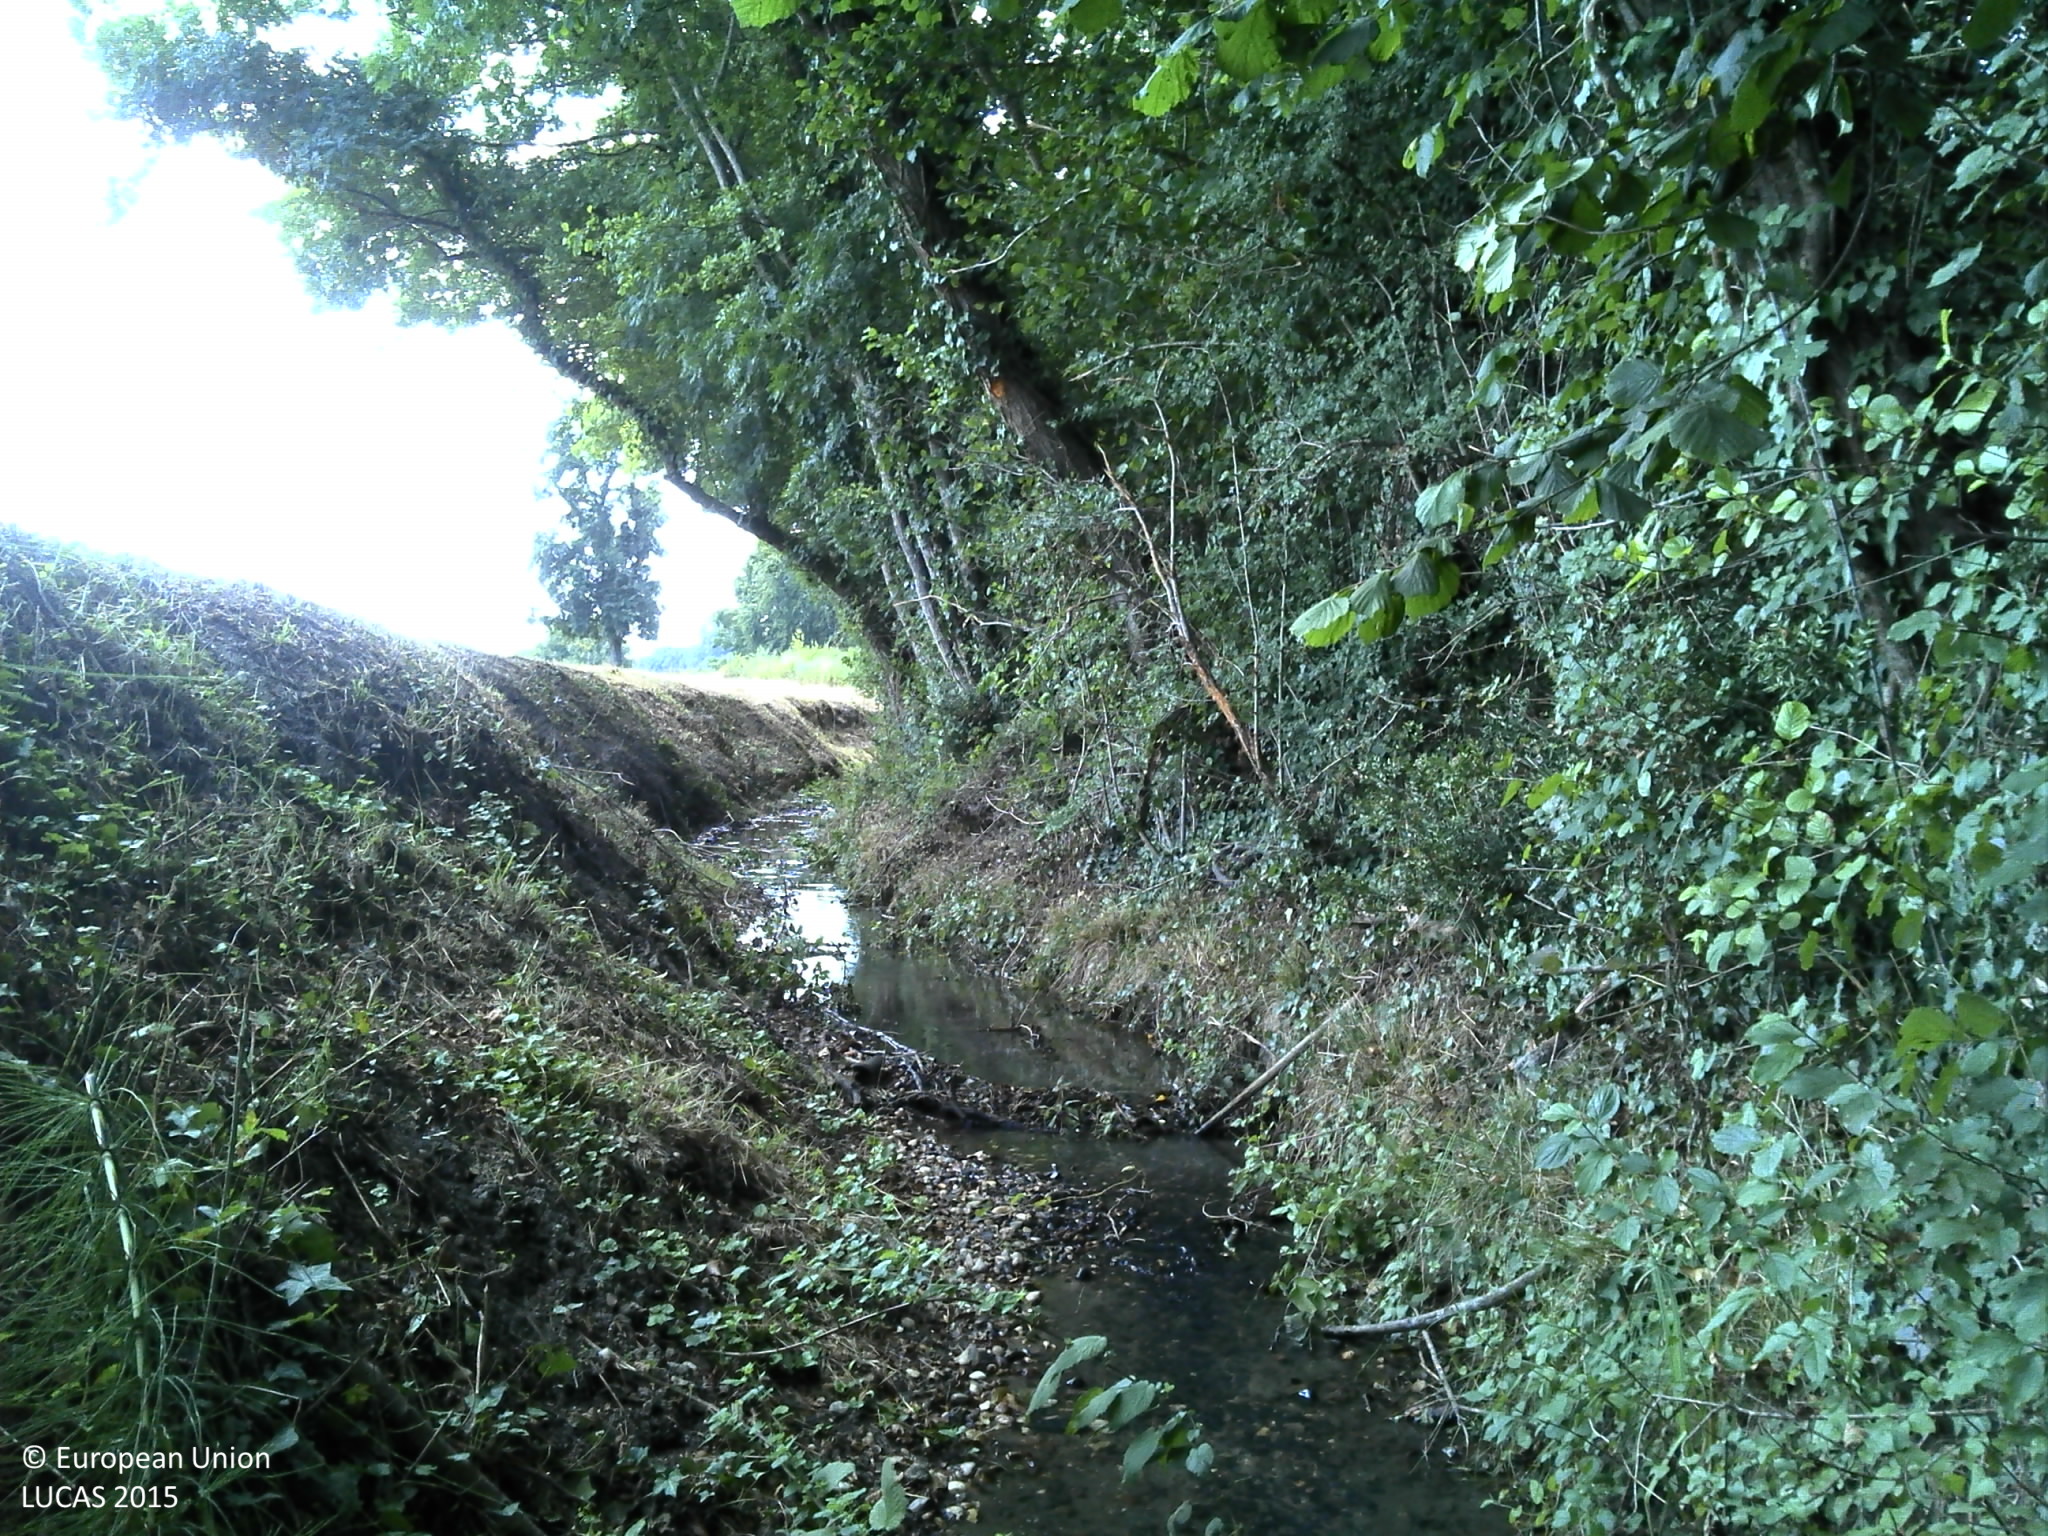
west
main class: Woodland
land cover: Broadleaved woodland
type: floodplain forest
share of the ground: > 75 %
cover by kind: broadleaved forest trees 100 %
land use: Semi-natural and natural areas not in use
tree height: > 5 m
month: August
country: FR
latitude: 45.0169
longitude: -0.6670
